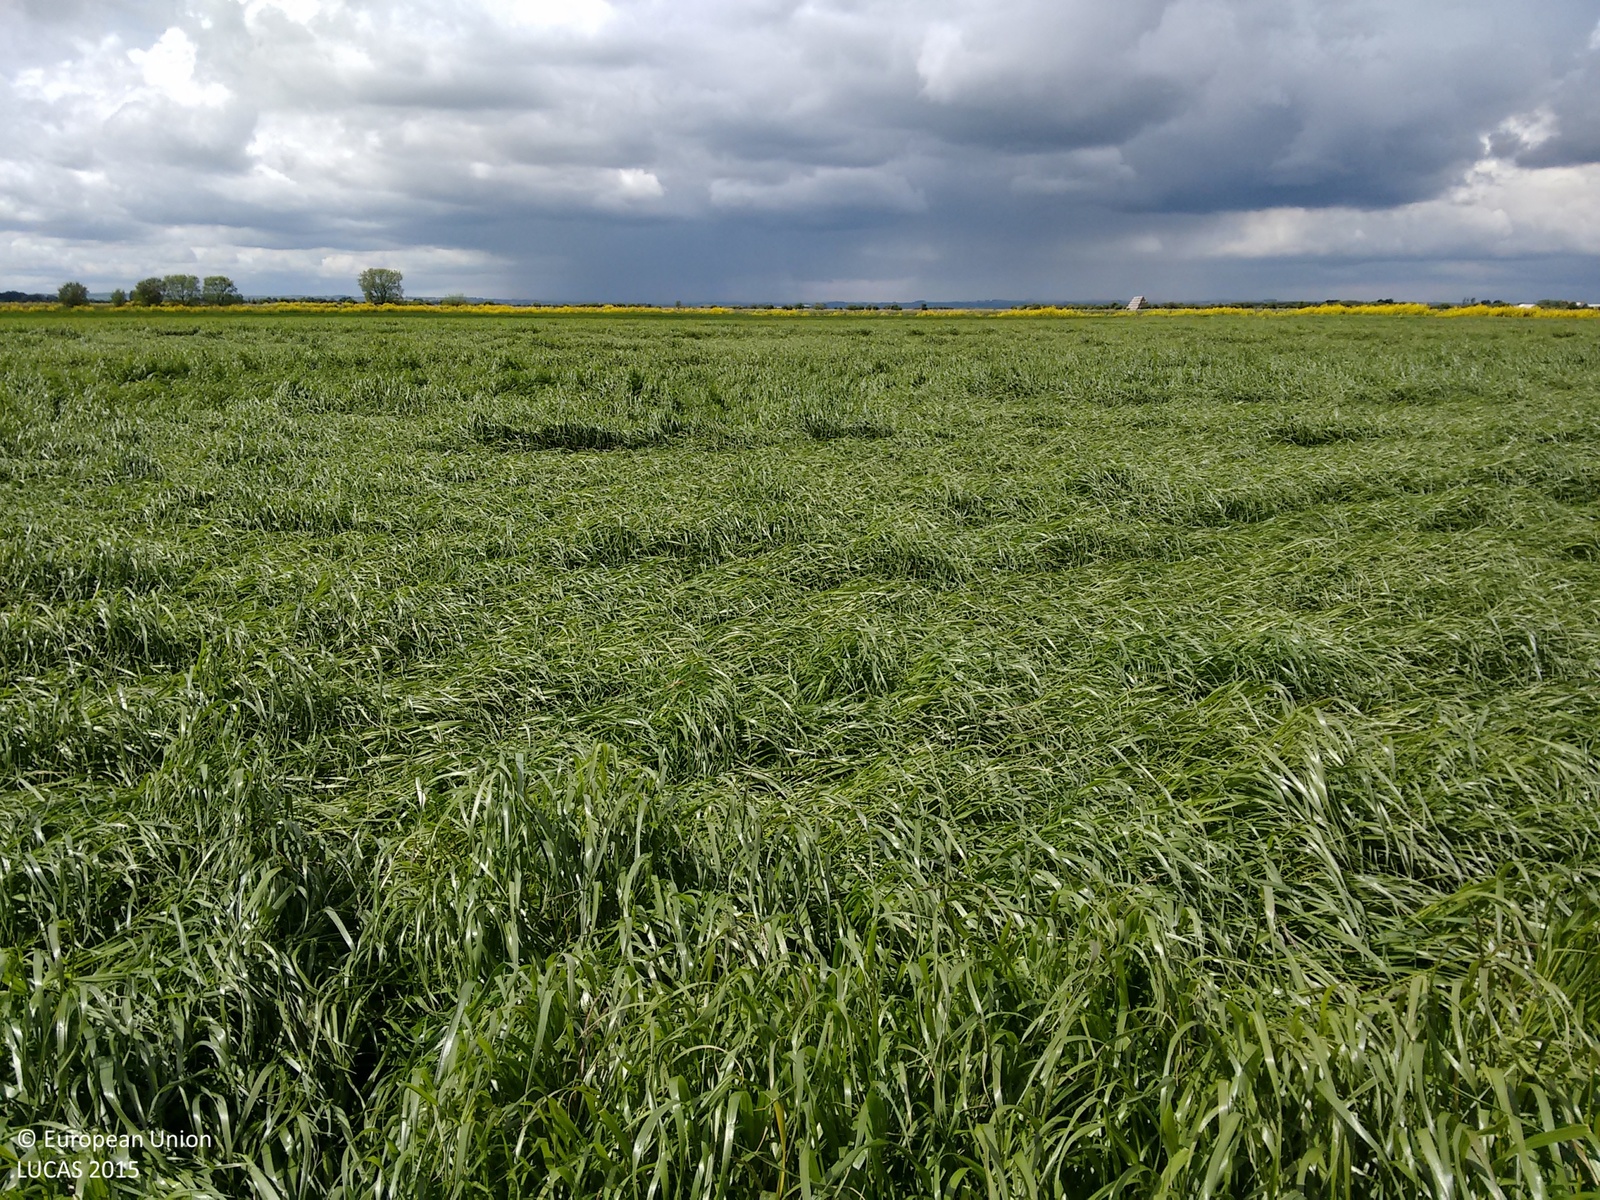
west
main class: Cropland
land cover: Common wheat
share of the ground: > 75 %
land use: Agriculture (excluding fallow land and kitchen gardens)
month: May
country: GB
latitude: 53.4004
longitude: 0.1789
